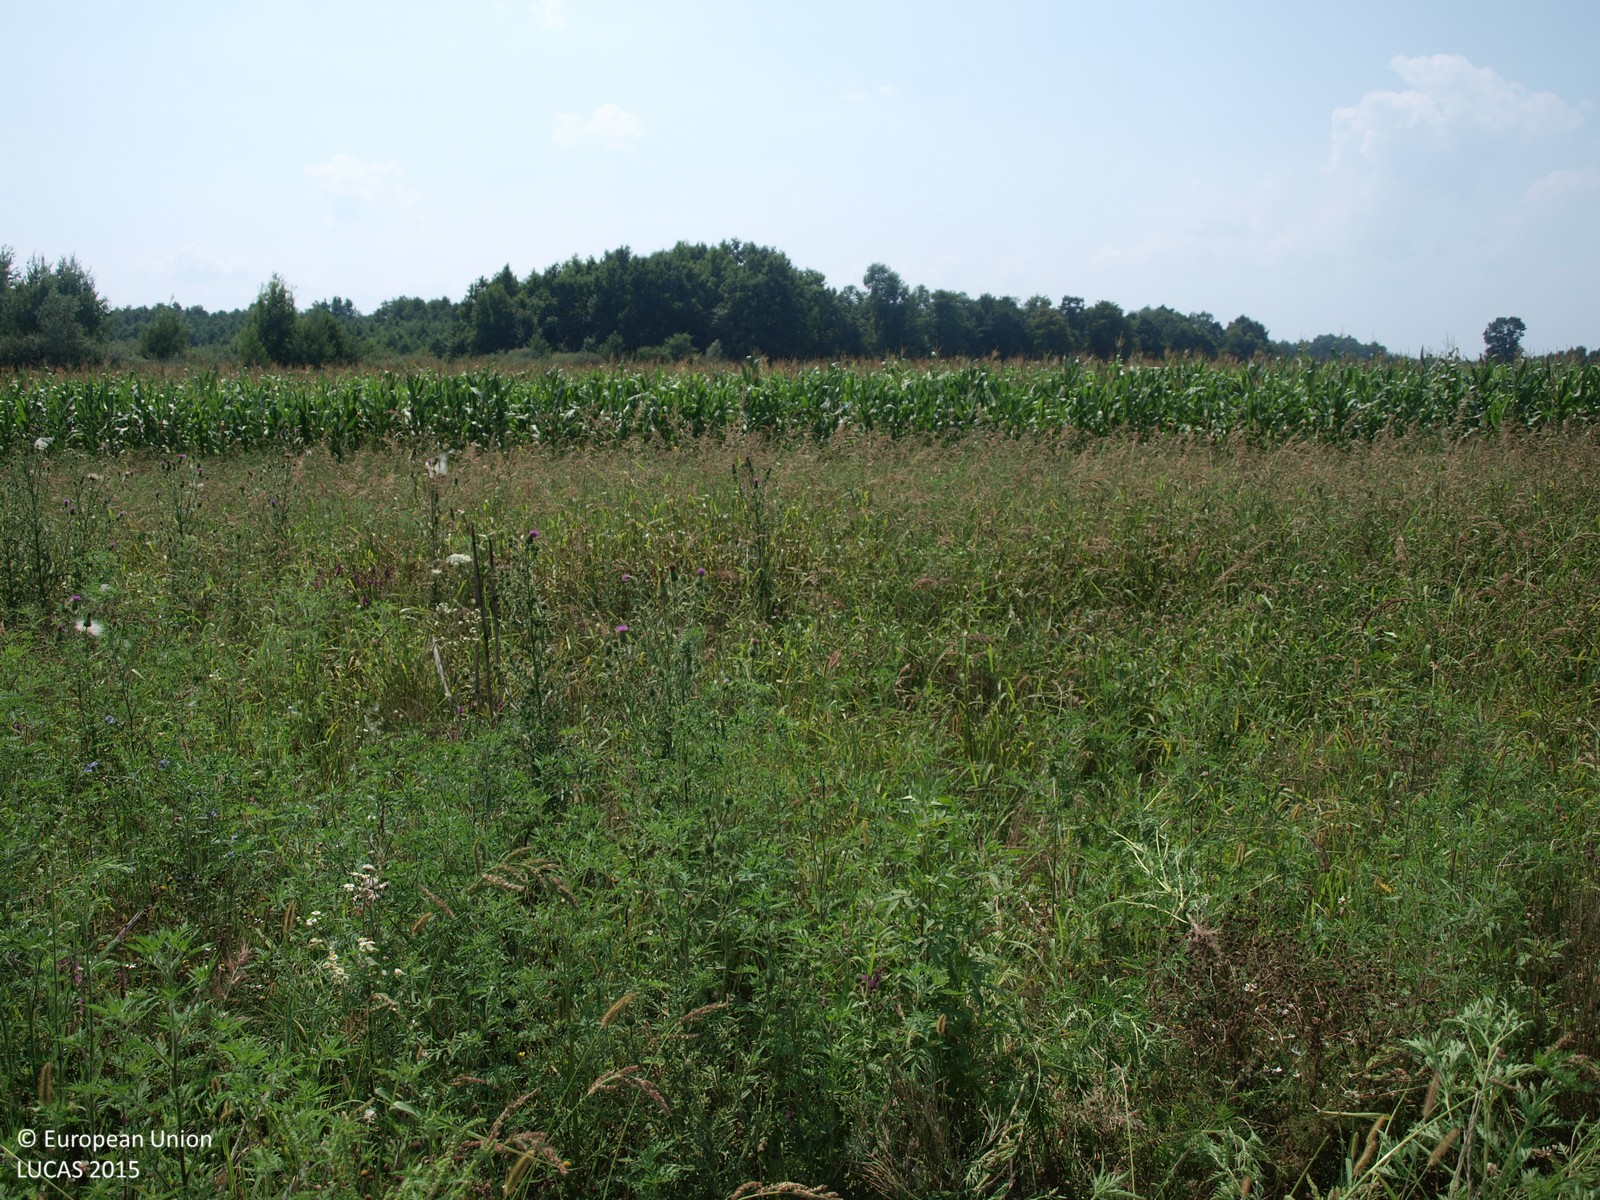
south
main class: Grassland
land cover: Grassland without tree/shrub cover
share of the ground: > 75 %
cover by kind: herbaceous plants 100 %
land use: Abandoned areas
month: August
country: HR
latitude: 45.8524
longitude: 16.3995
